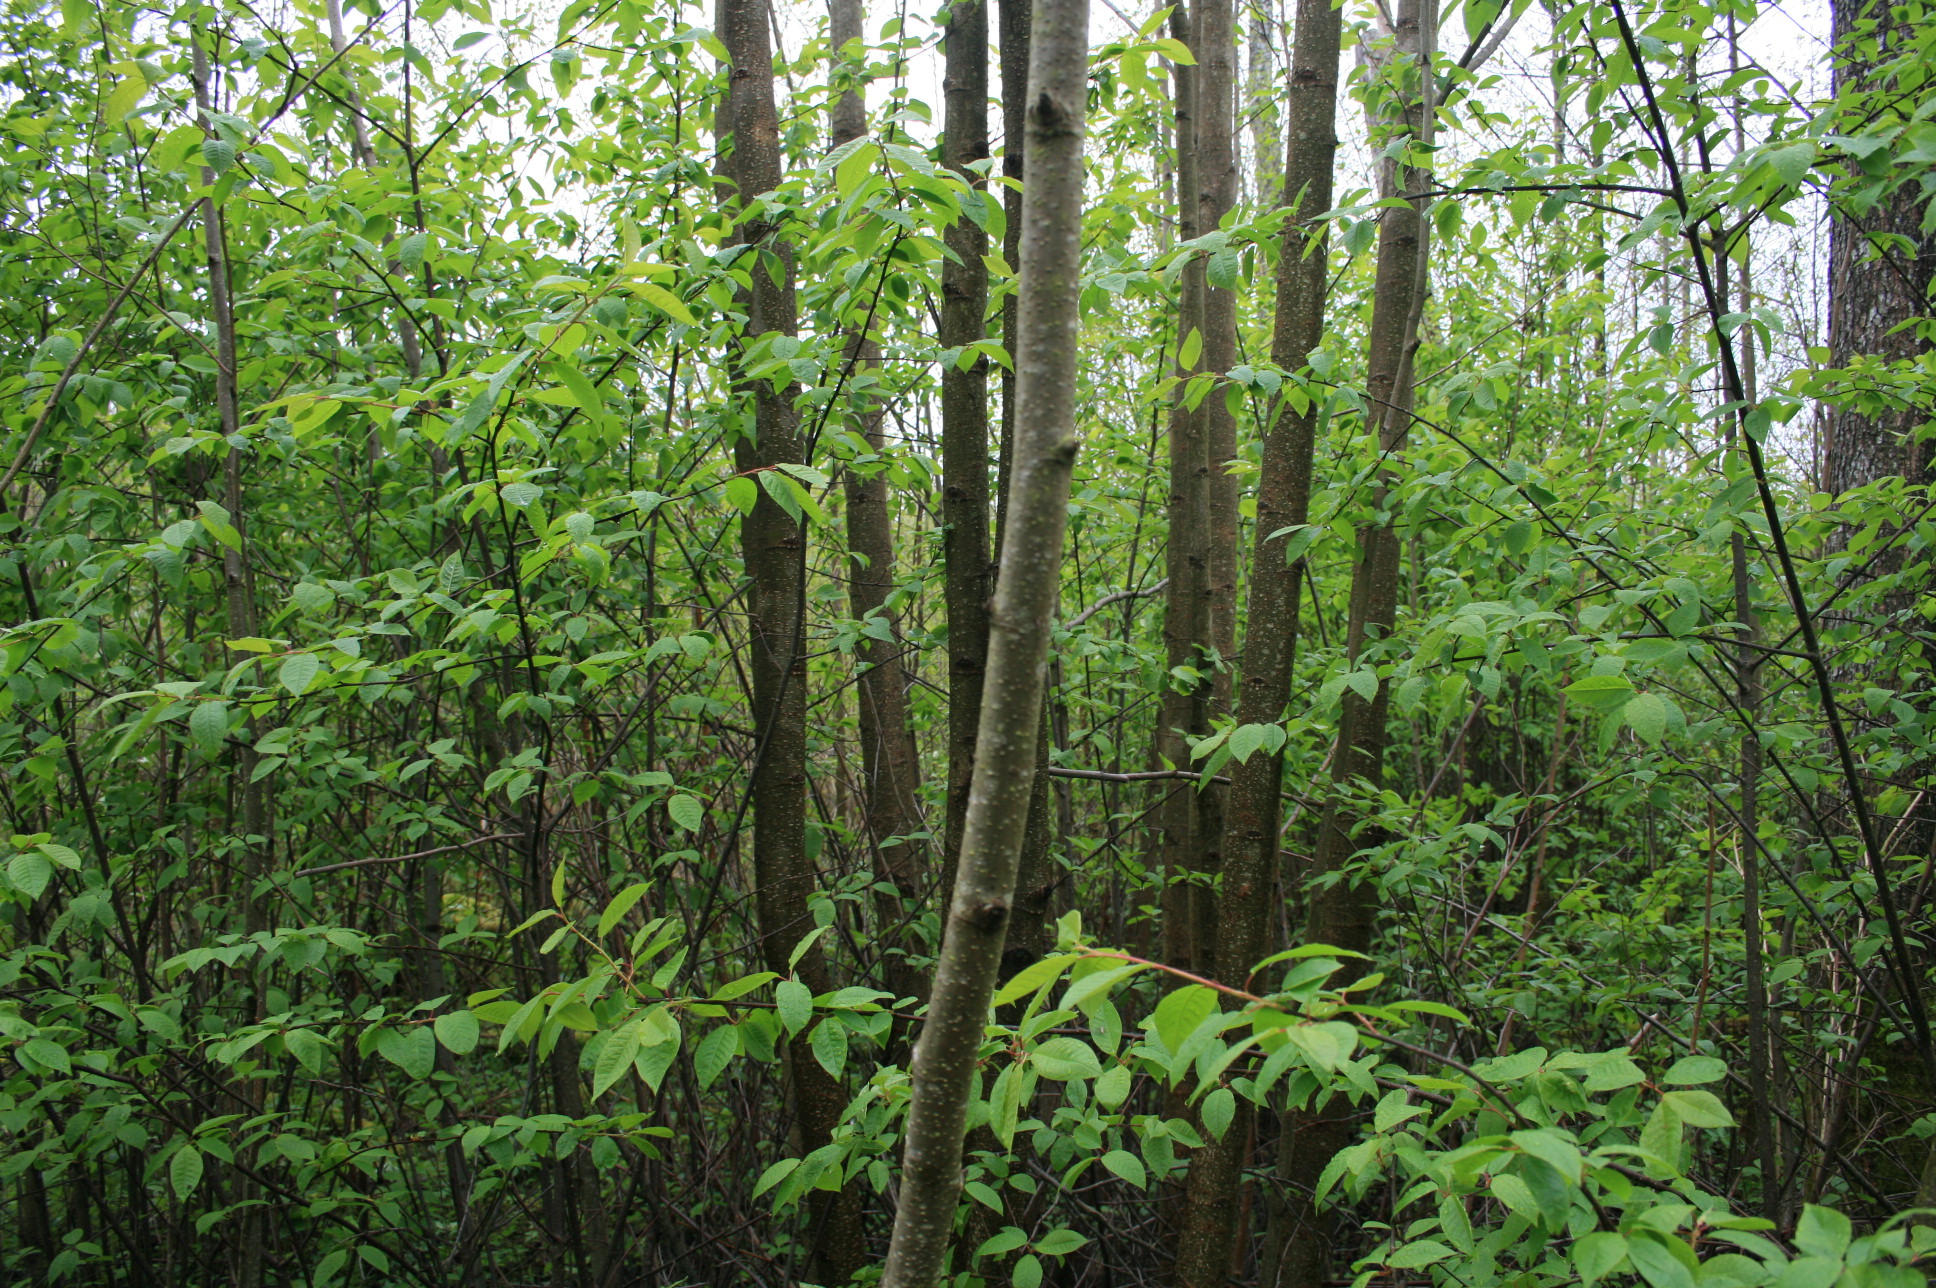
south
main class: Woodland
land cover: Broadleaved woodland
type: non-riverine alder, birch or aspen forest
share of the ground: 50 - 75 %
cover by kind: broadleaved forest trees 70 %, shrubs 20 %, herbaceous plants 10 %
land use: Forestry
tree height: > 5 m
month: May
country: LT
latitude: 56.3758
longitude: 22.1150
